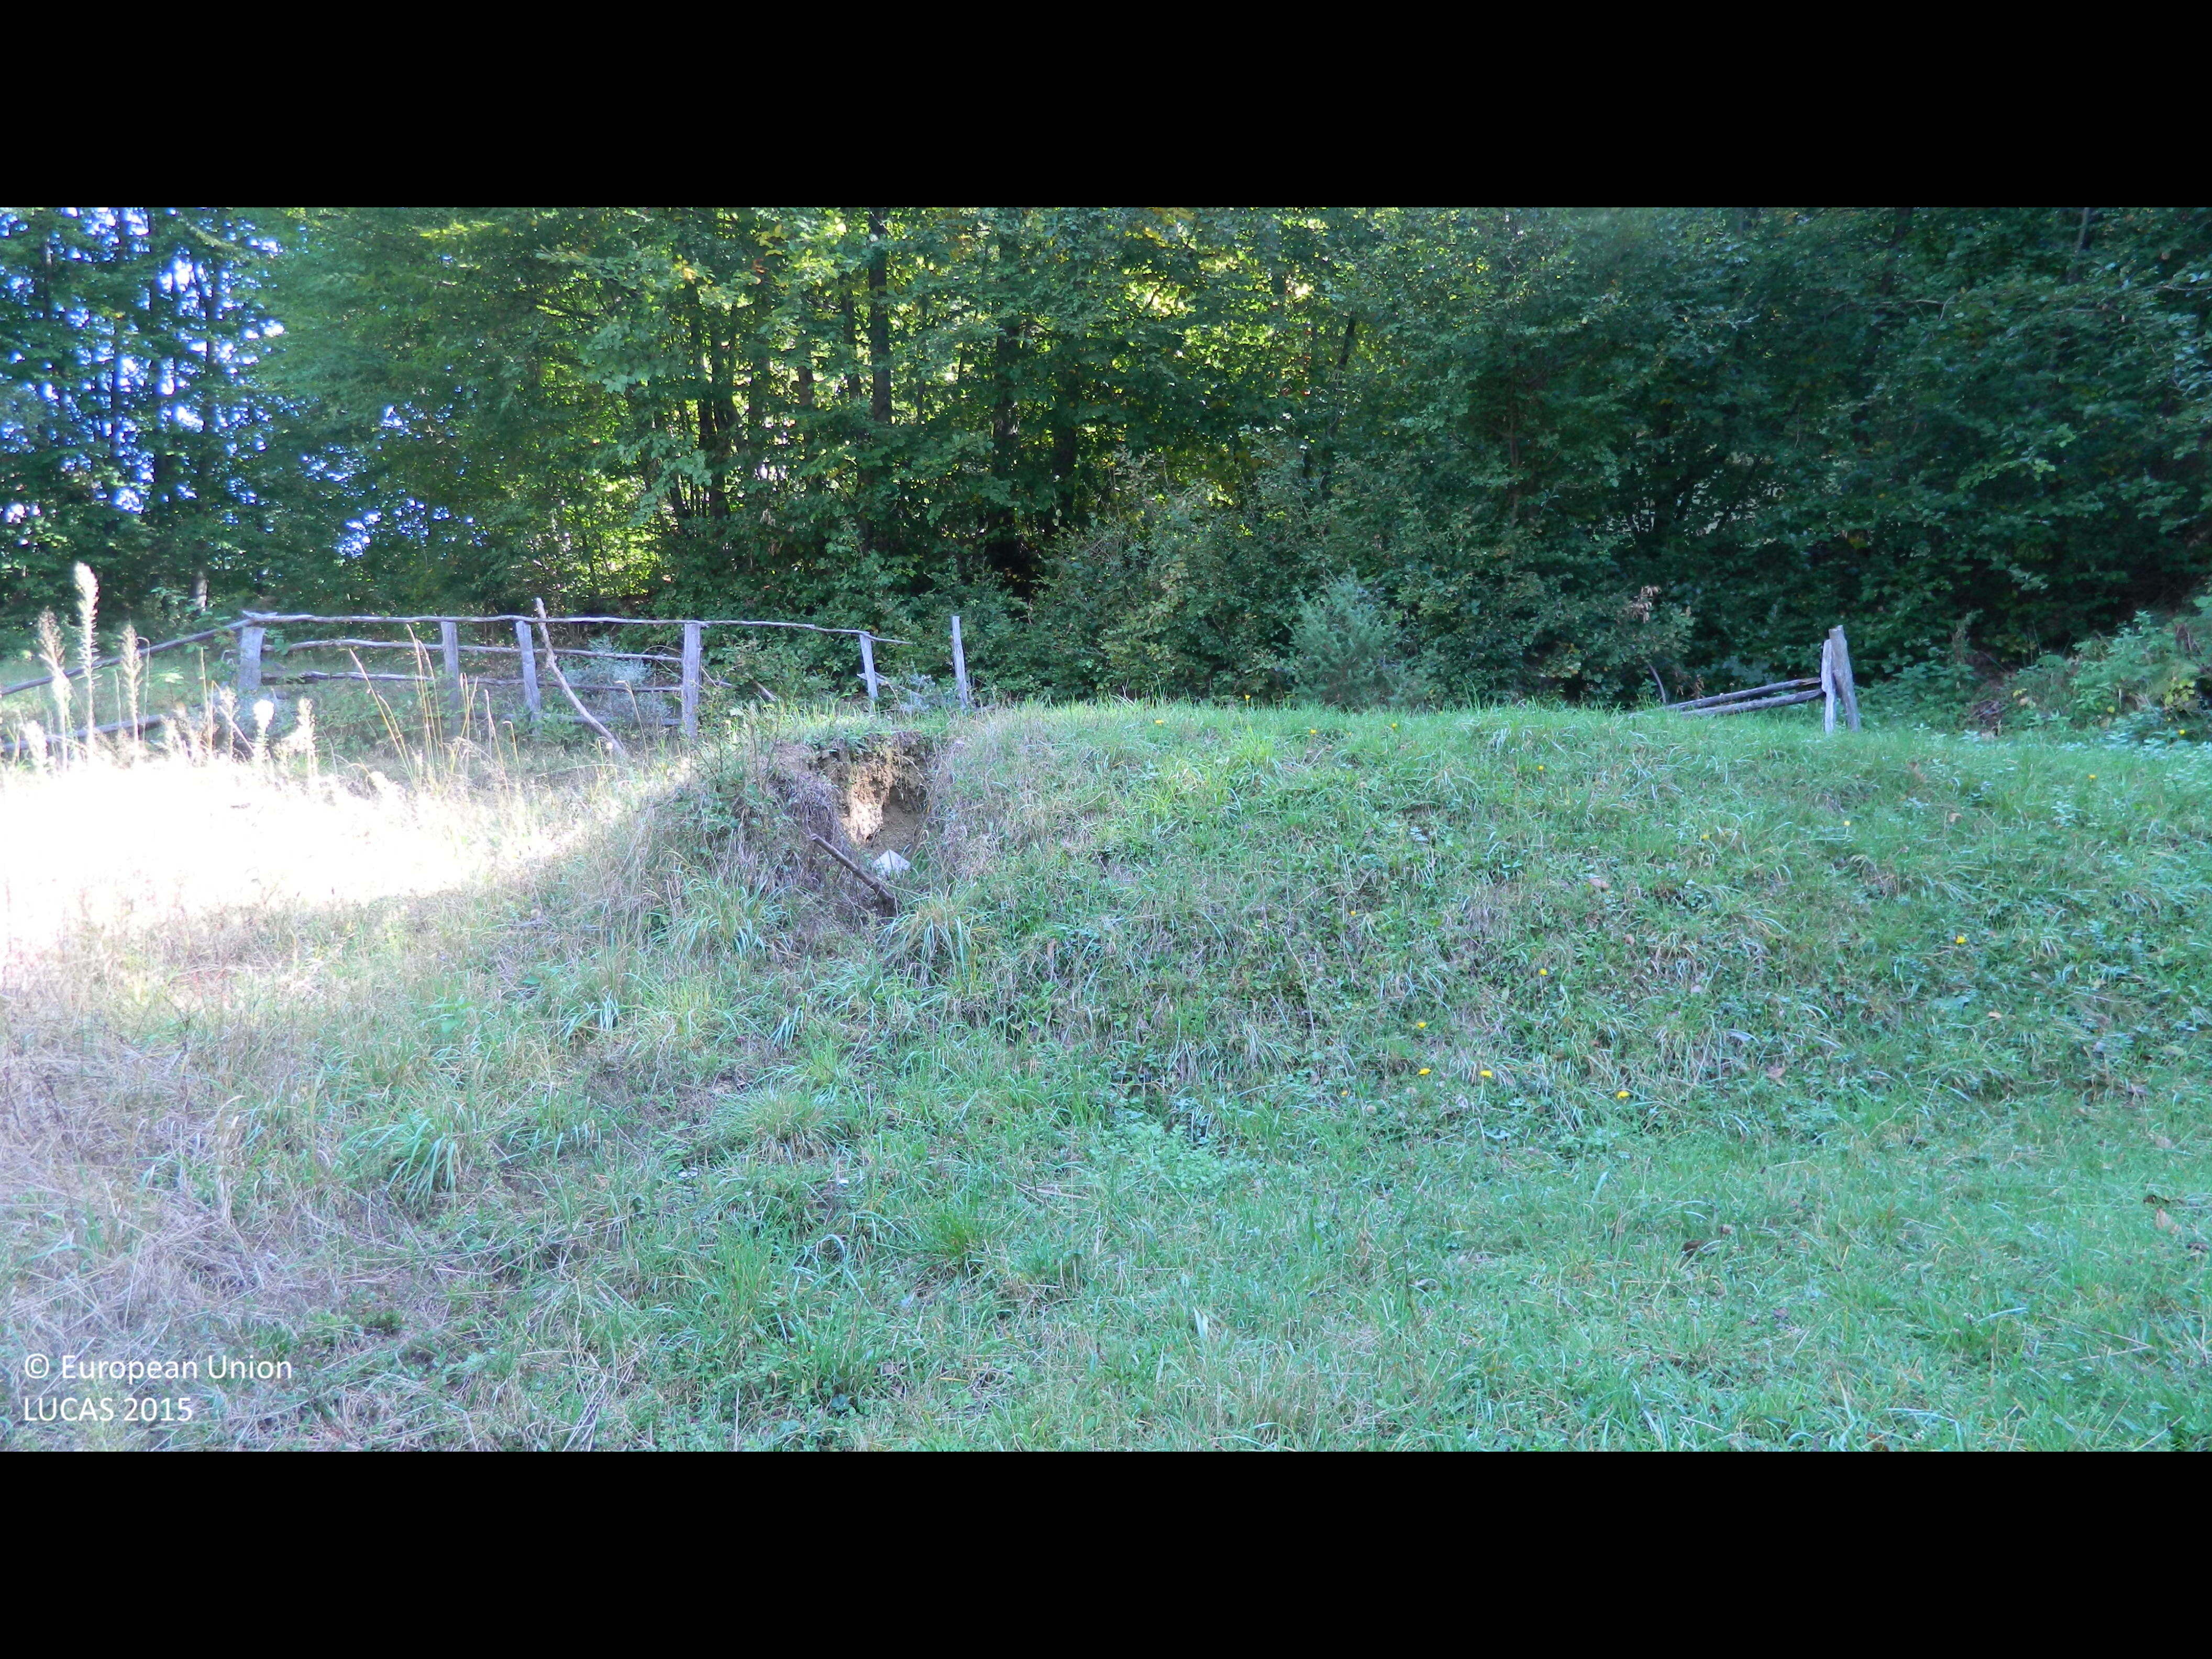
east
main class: Grassland
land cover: Spontaneously vegetated surfaces
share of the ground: > 75 %
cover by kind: herbaceous plants 100 %
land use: Agriculture (excluding fallow land and kitchen gardens)
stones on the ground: < 10 %
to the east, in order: Spontaneously vegetated surfaces; Fences; Tracks; Broadleaved woodland; Grassland without tree/shrub cover; Artificial constructions in urban areas; Other fresh vegetables; Fences; Grassland without tree/shrub cover
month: October
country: BG
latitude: 41.5094
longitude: 25.0130
